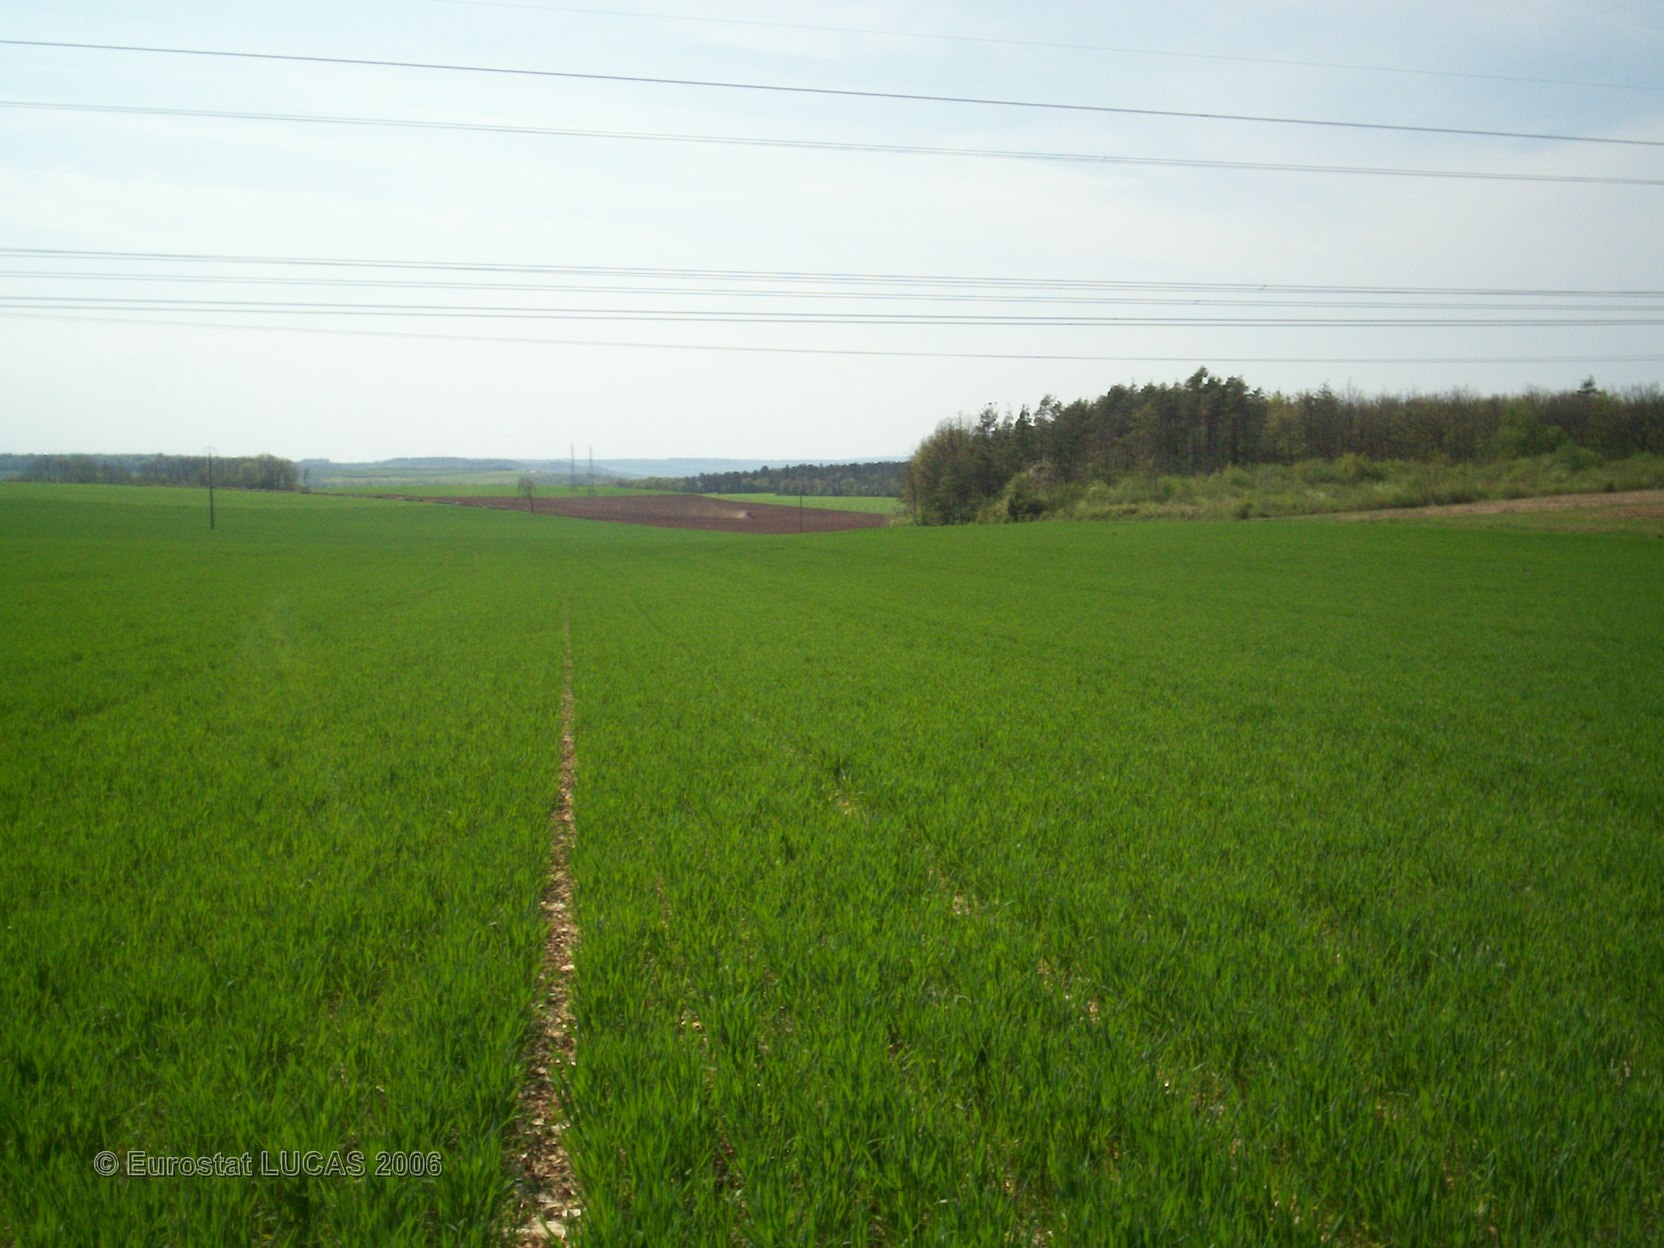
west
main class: Cropland
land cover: Common wheat
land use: Agriculture (excluding fallow land and kitchen gardens)
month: May
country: FR
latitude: 47.5317
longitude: 4.5930
